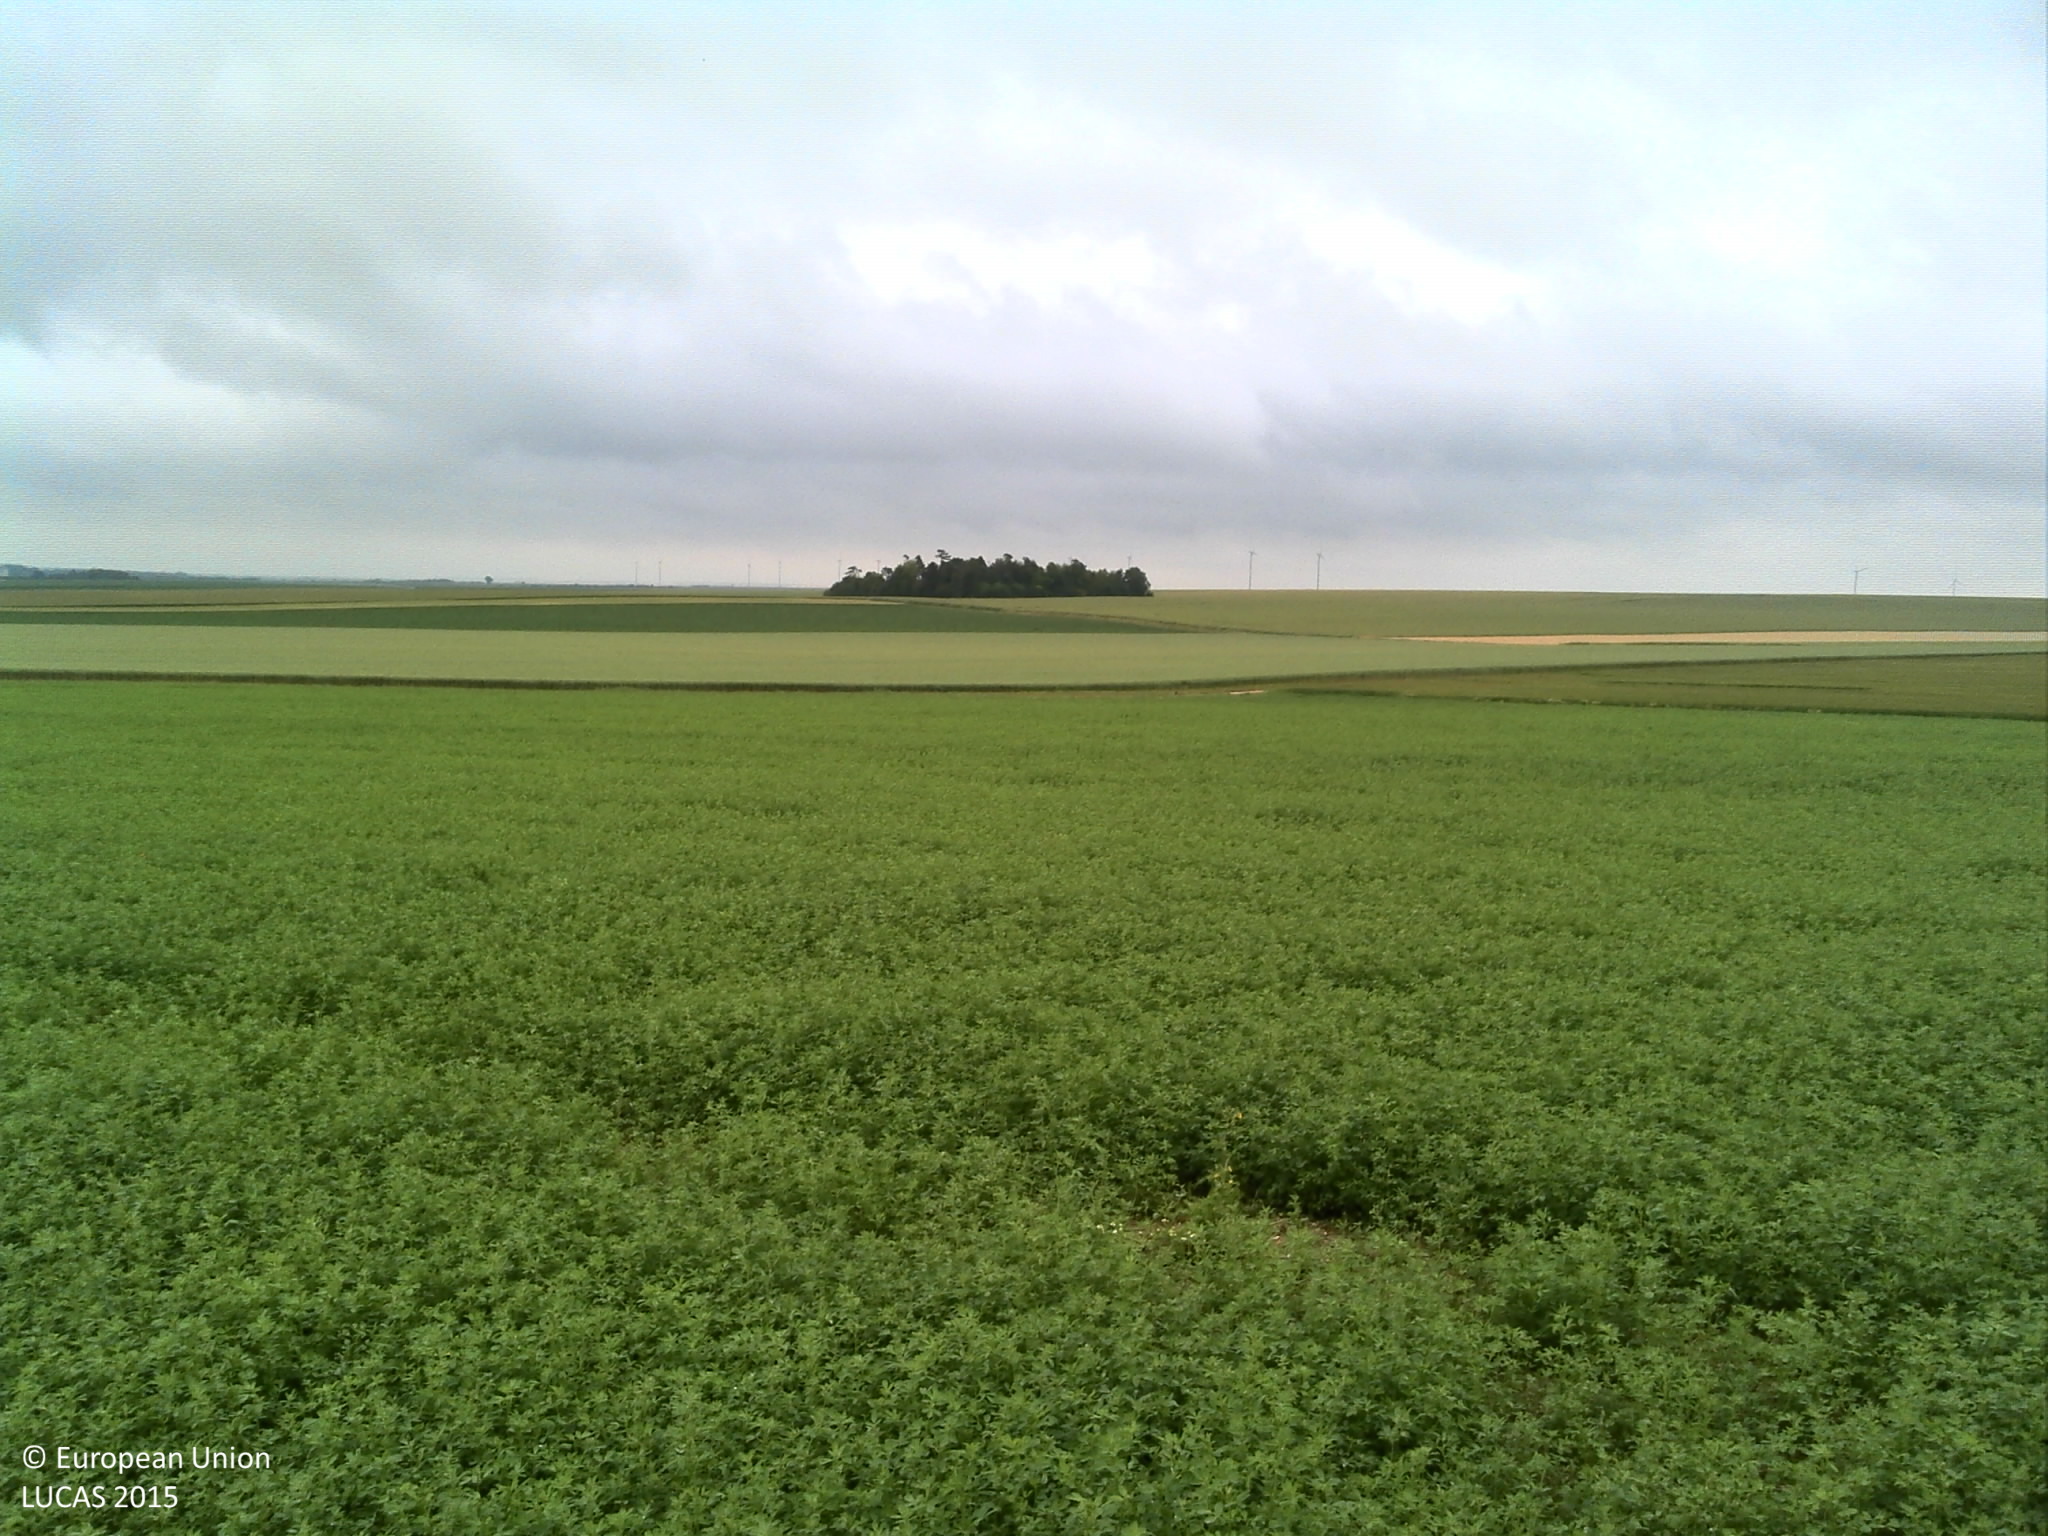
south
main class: Cropland
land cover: Lucerne
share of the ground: > 75 %
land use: Agriculture (excluding fallow land and kitchen gardens)
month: June
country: FR
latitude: 48.6302
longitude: 4.2025
